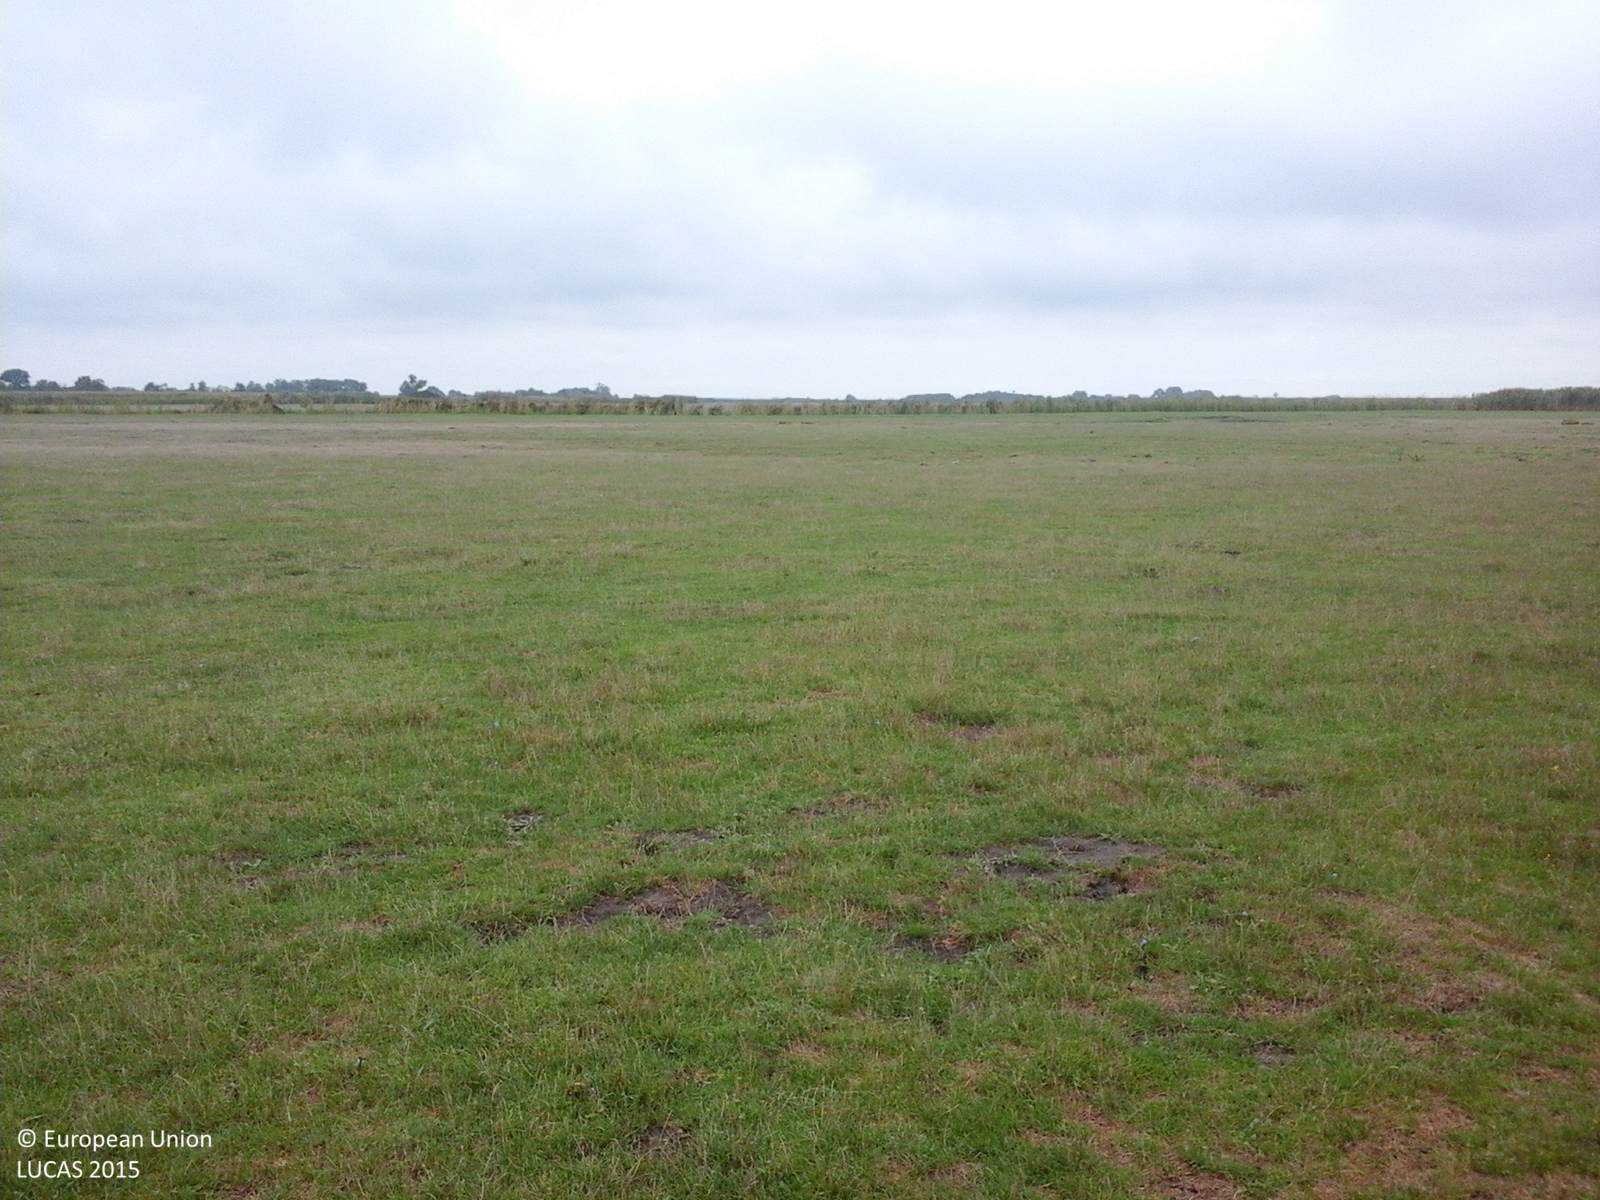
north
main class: Grassland
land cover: Grassland without tree/shrub cover
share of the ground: > 75 %
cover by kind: herbaceous plants 100 %
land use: Agriculture (excluding fallow land and kitchen gardens)
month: September
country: RO
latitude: 46.9823
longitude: 21.6775
